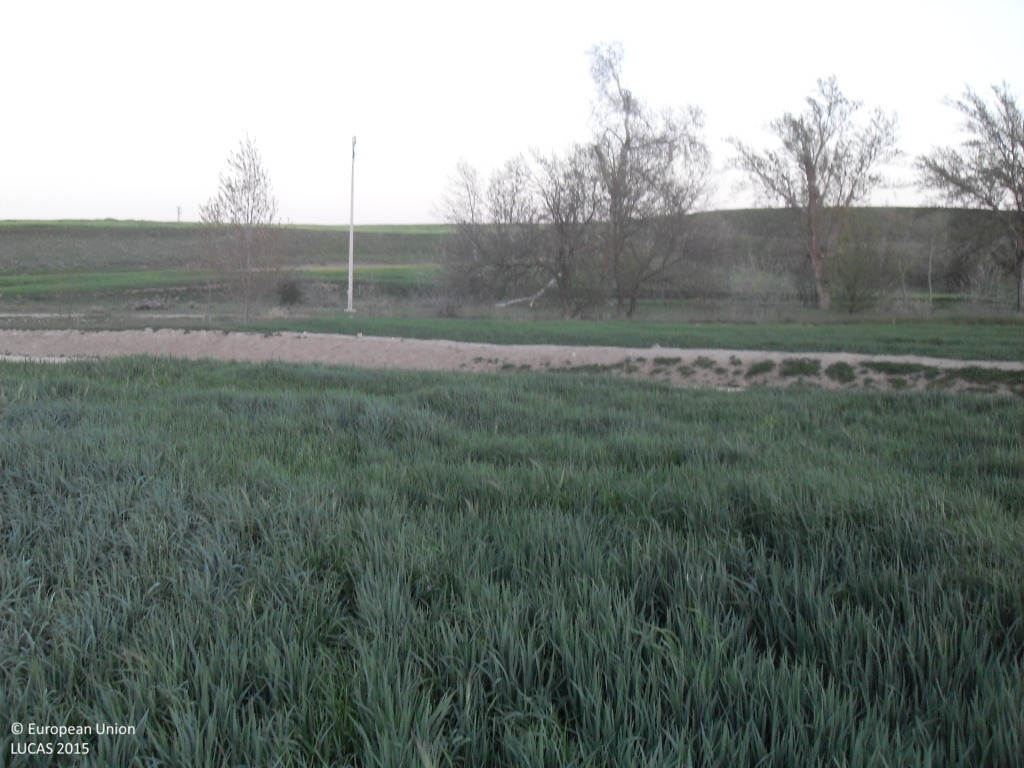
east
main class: Cropland
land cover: Oats
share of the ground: > 75 %
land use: Agriculture (excluding fallow land and kitchen gardens)
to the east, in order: Oats; Grass margins; Tracks; Grass margins; Grassland without tree/shrub cover; Tracks; Electric lines; Grassland without tree/shrub cover; Barley; Spontaneously vegetated surfaces; Barley
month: April
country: ES
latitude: 40.8544
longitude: -5.2155
